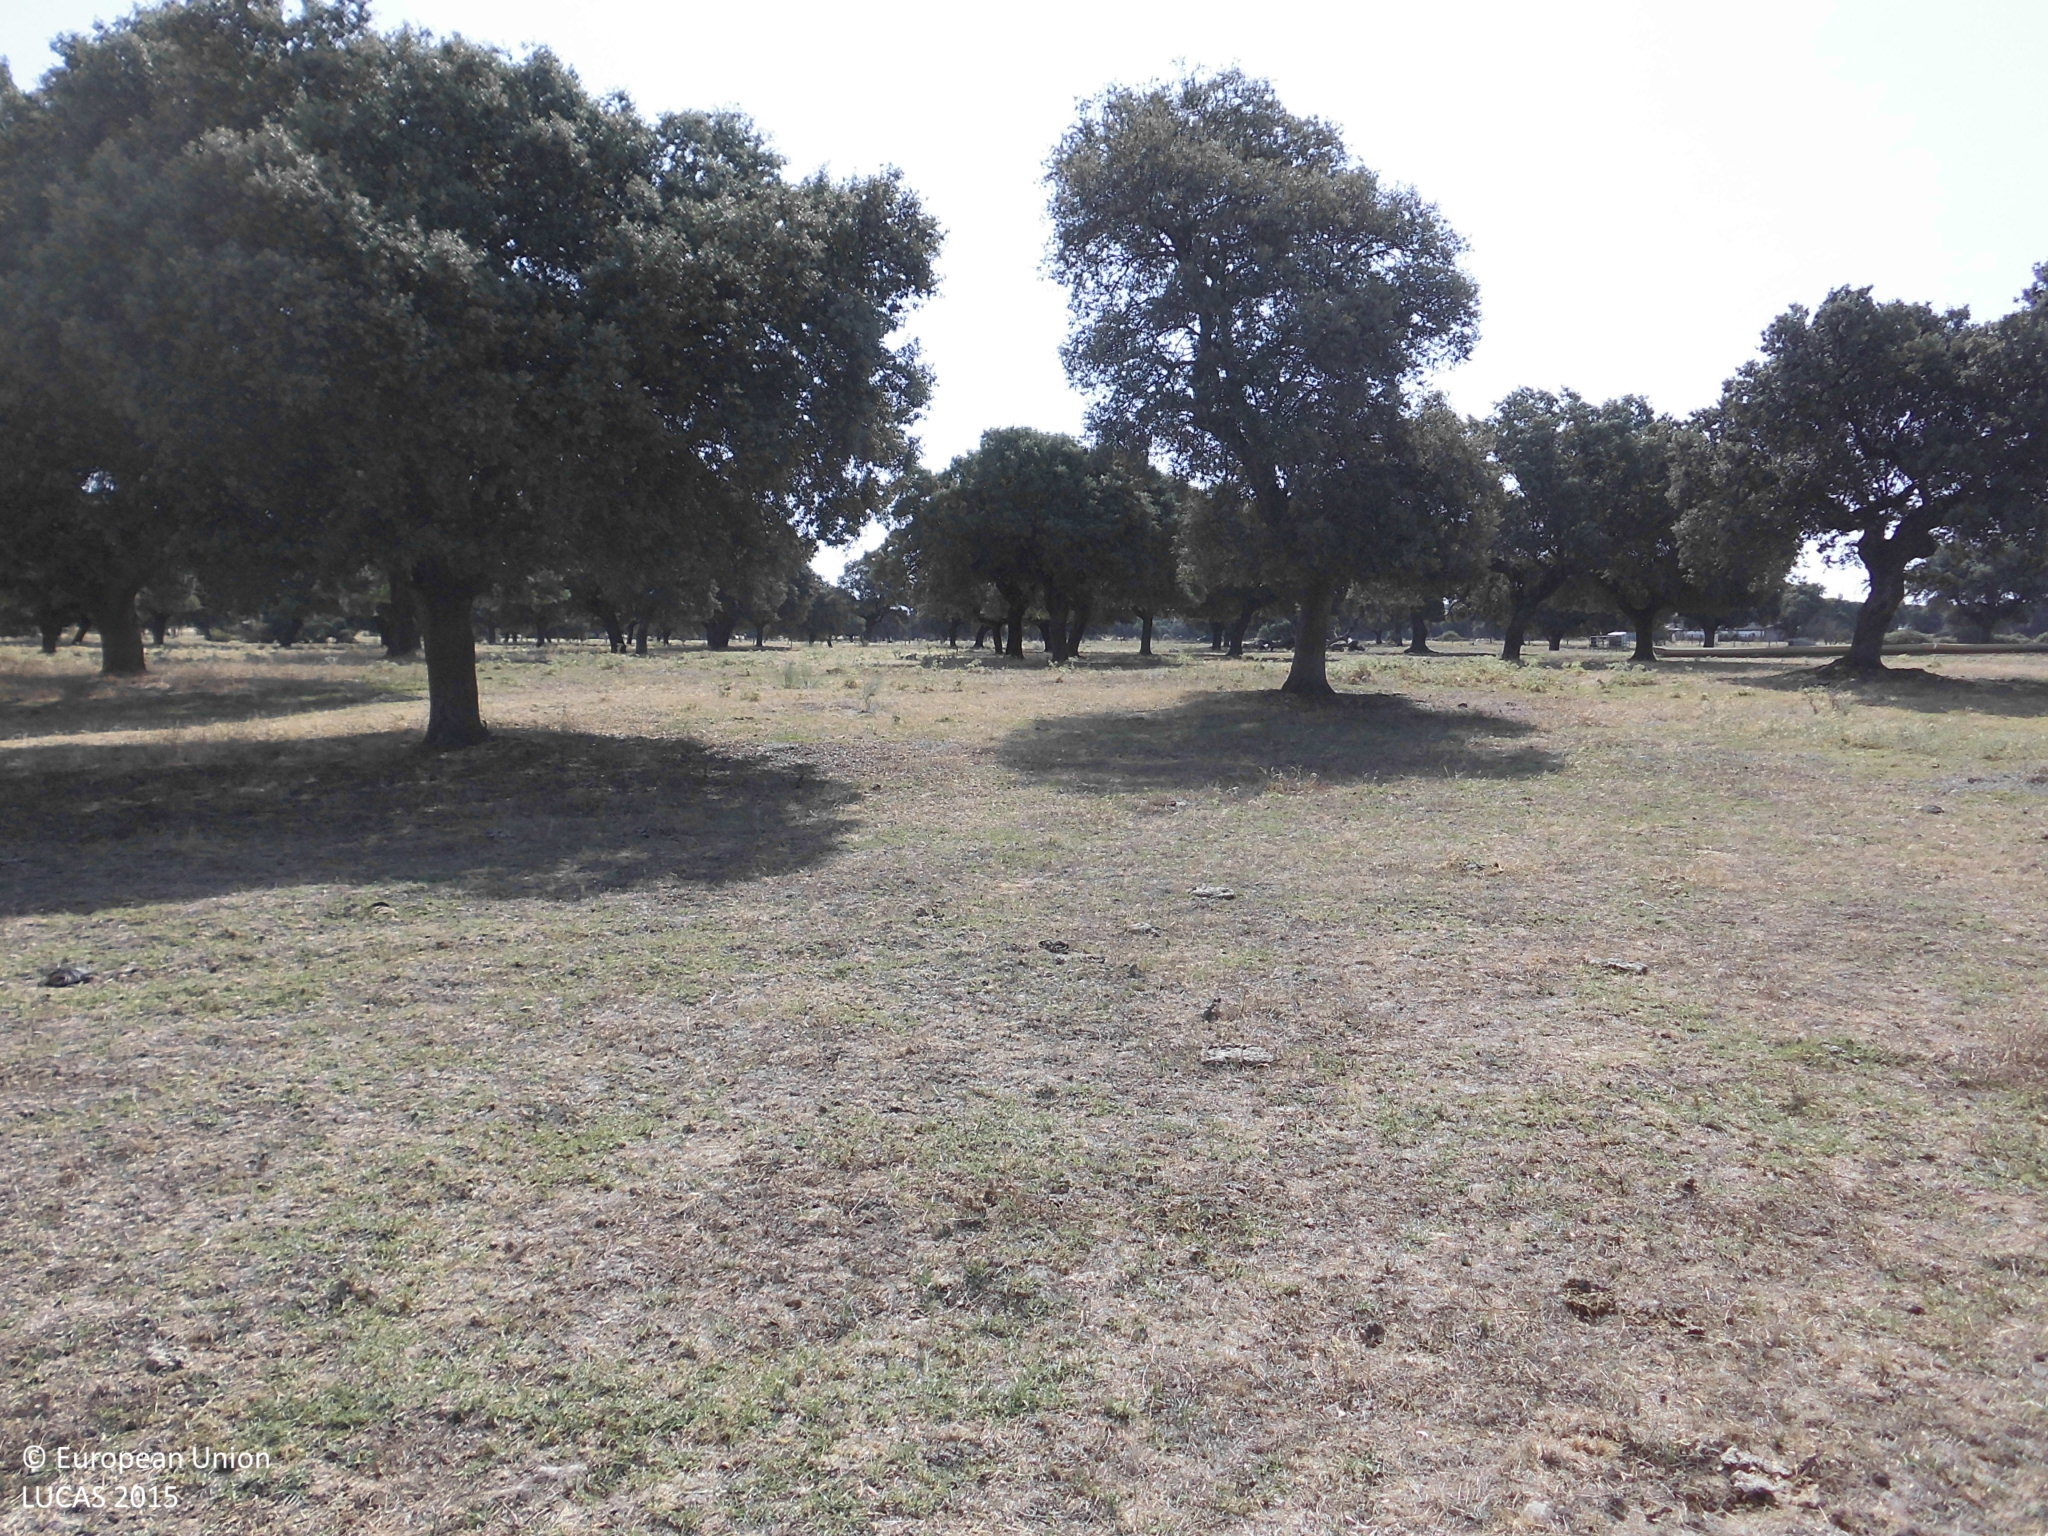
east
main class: Woodland
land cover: Broadleaved woodland
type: broadleaved evergreen forest
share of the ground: 10 - 25 %
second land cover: Grassland without tree/shrub cover
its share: > 75 %
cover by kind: herbaceous plants 90 %, broadleaved forest trees 10 %
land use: Forestry
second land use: Agriculture (excluding fallow land and kitchen gardens)
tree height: > 5 m
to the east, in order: Broadleaved woodland; Grassland without tree/shrub cover; Broadleaved woodland; Rivers and streams; Broadleaved woodland; Fences; Grass margins; Tracks; Grass margins; Fences; Single bushes/trees
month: July
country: ES
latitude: 39.8937
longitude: -5.4838
